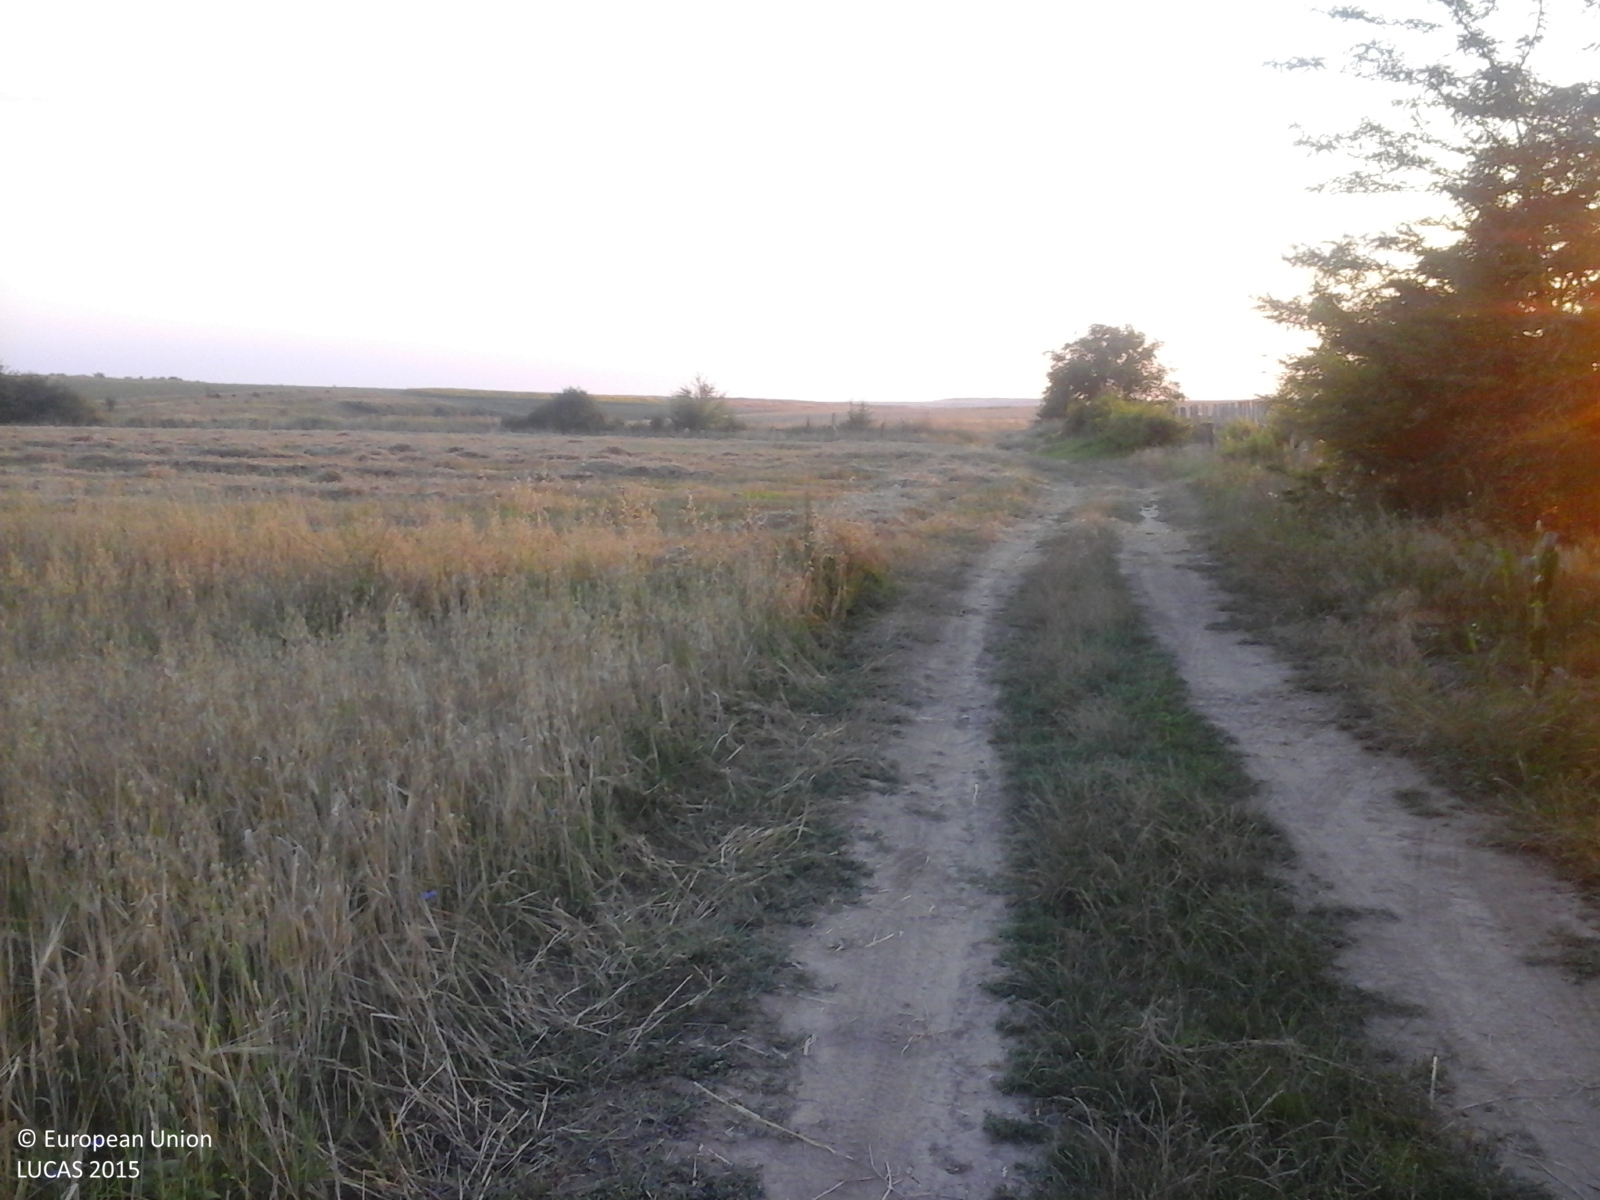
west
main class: Cropland
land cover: Maize
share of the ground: > 75 %
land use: Agriculture (excluding fallow land and kitchen gardens)
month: July
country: RO
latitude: 44.3628
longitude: 24.2822
